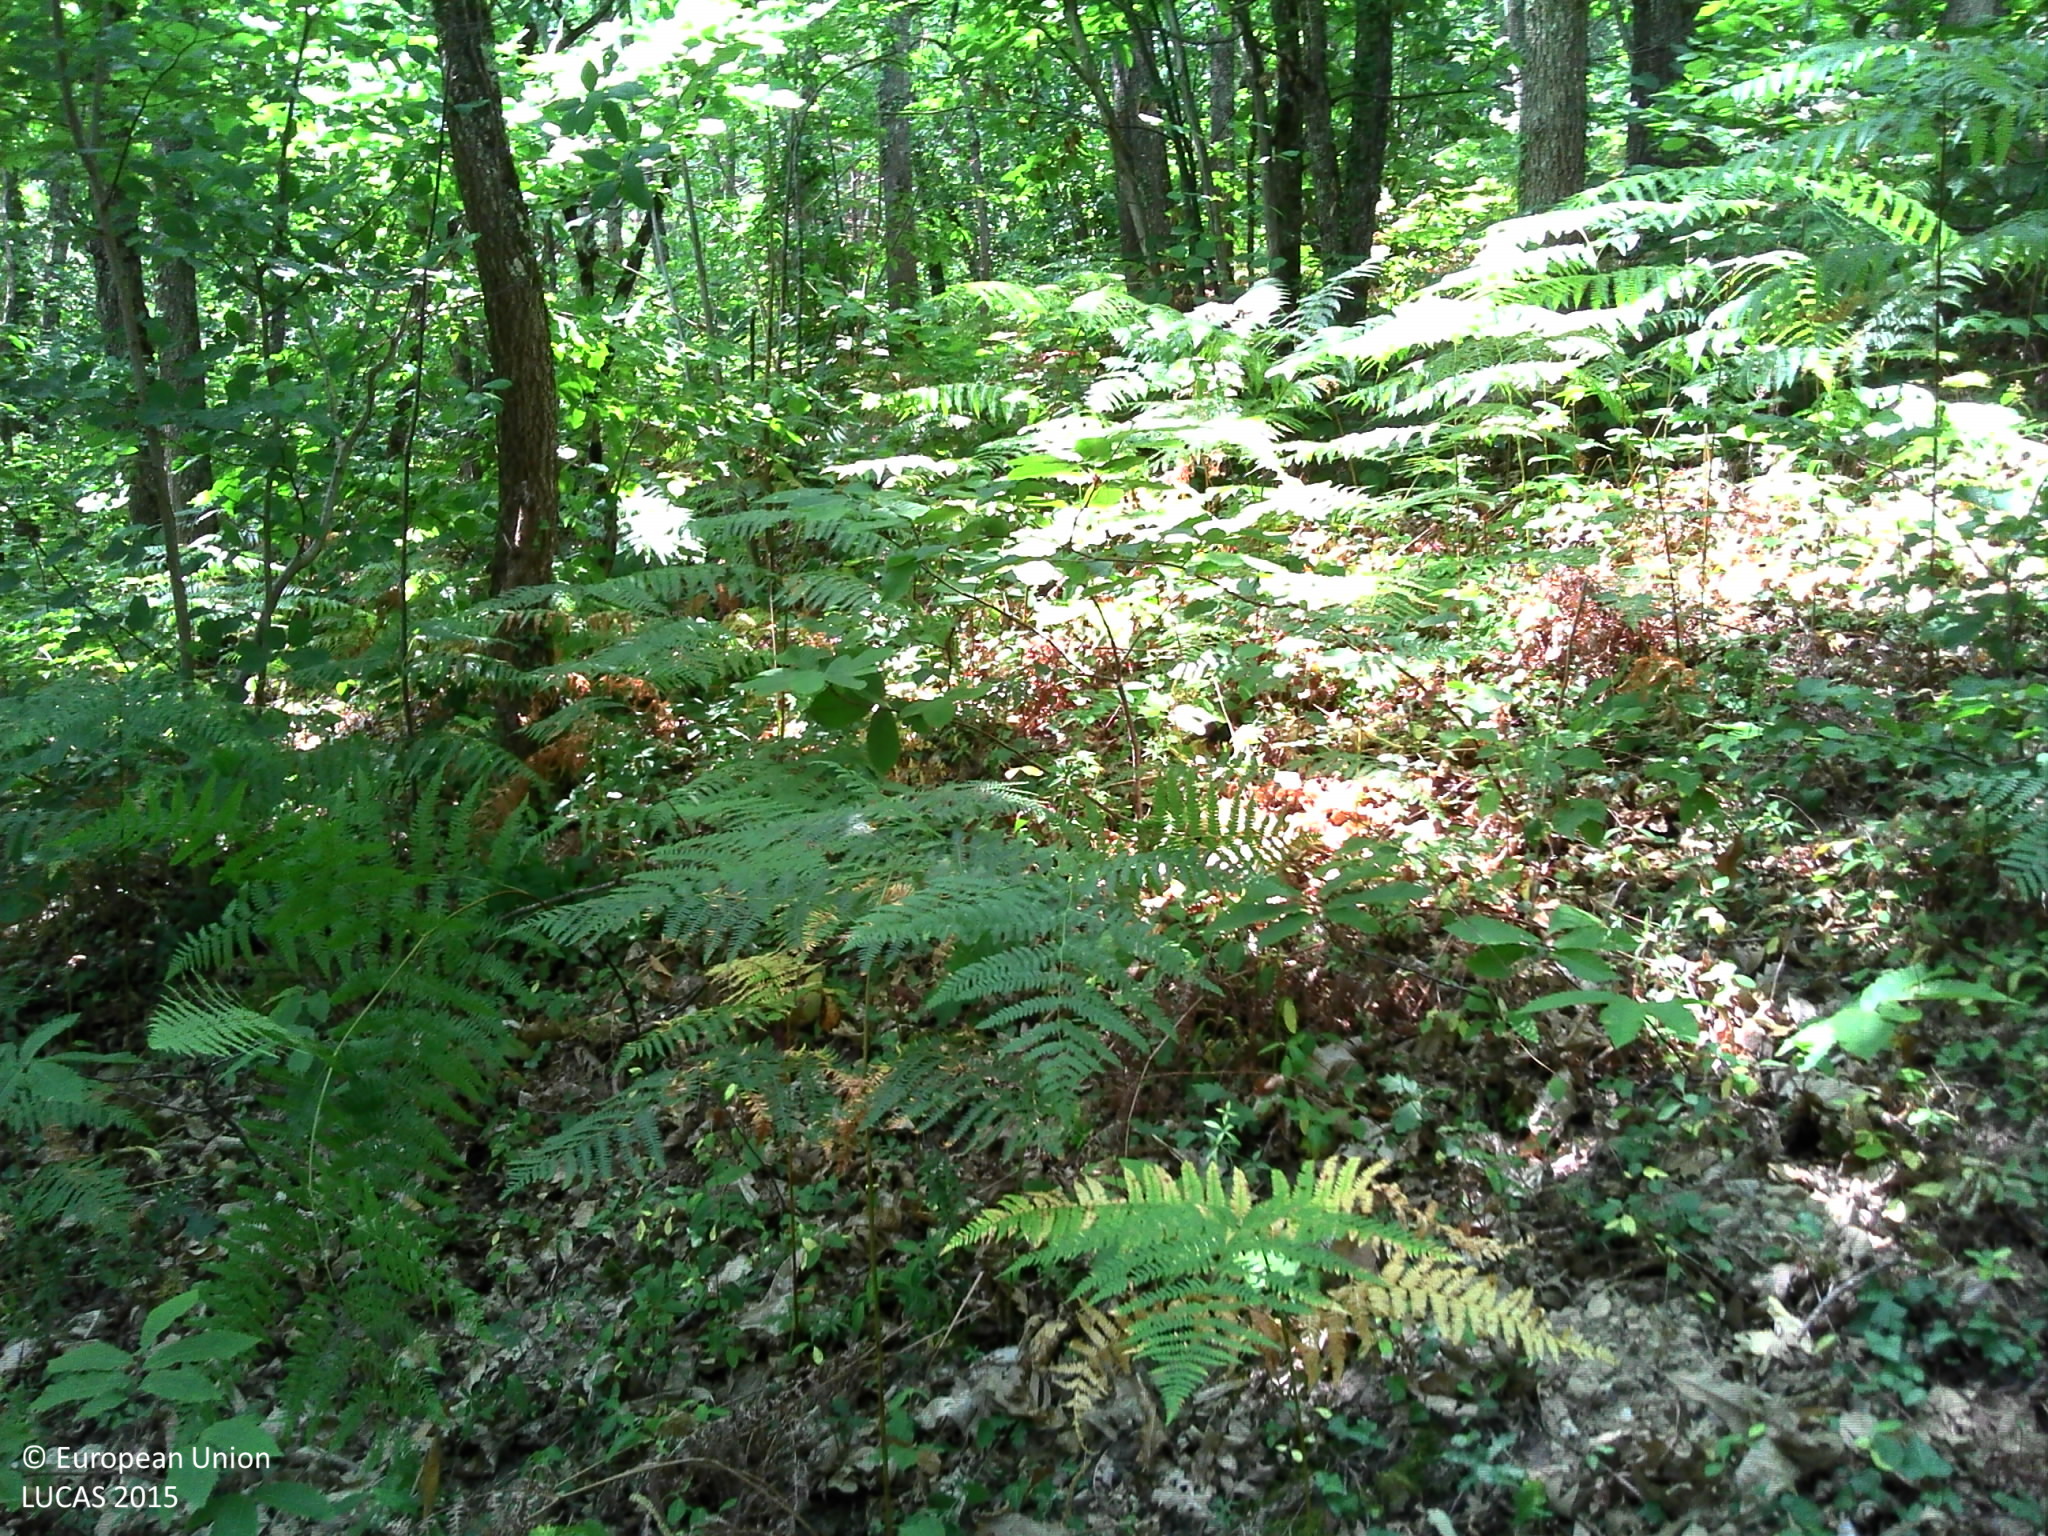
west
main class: Woodland
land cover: Broadleaved woodland
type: acidophilous oak and oak-birch forest
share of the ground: > 75 %
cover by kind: broadleaved forest trees 75 %, herbaceous plants 20 %, lichens and mosses 5 %
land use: Forestry
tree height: > 5 m
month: July
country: FR
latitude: 45.1380
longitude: 0.7969
